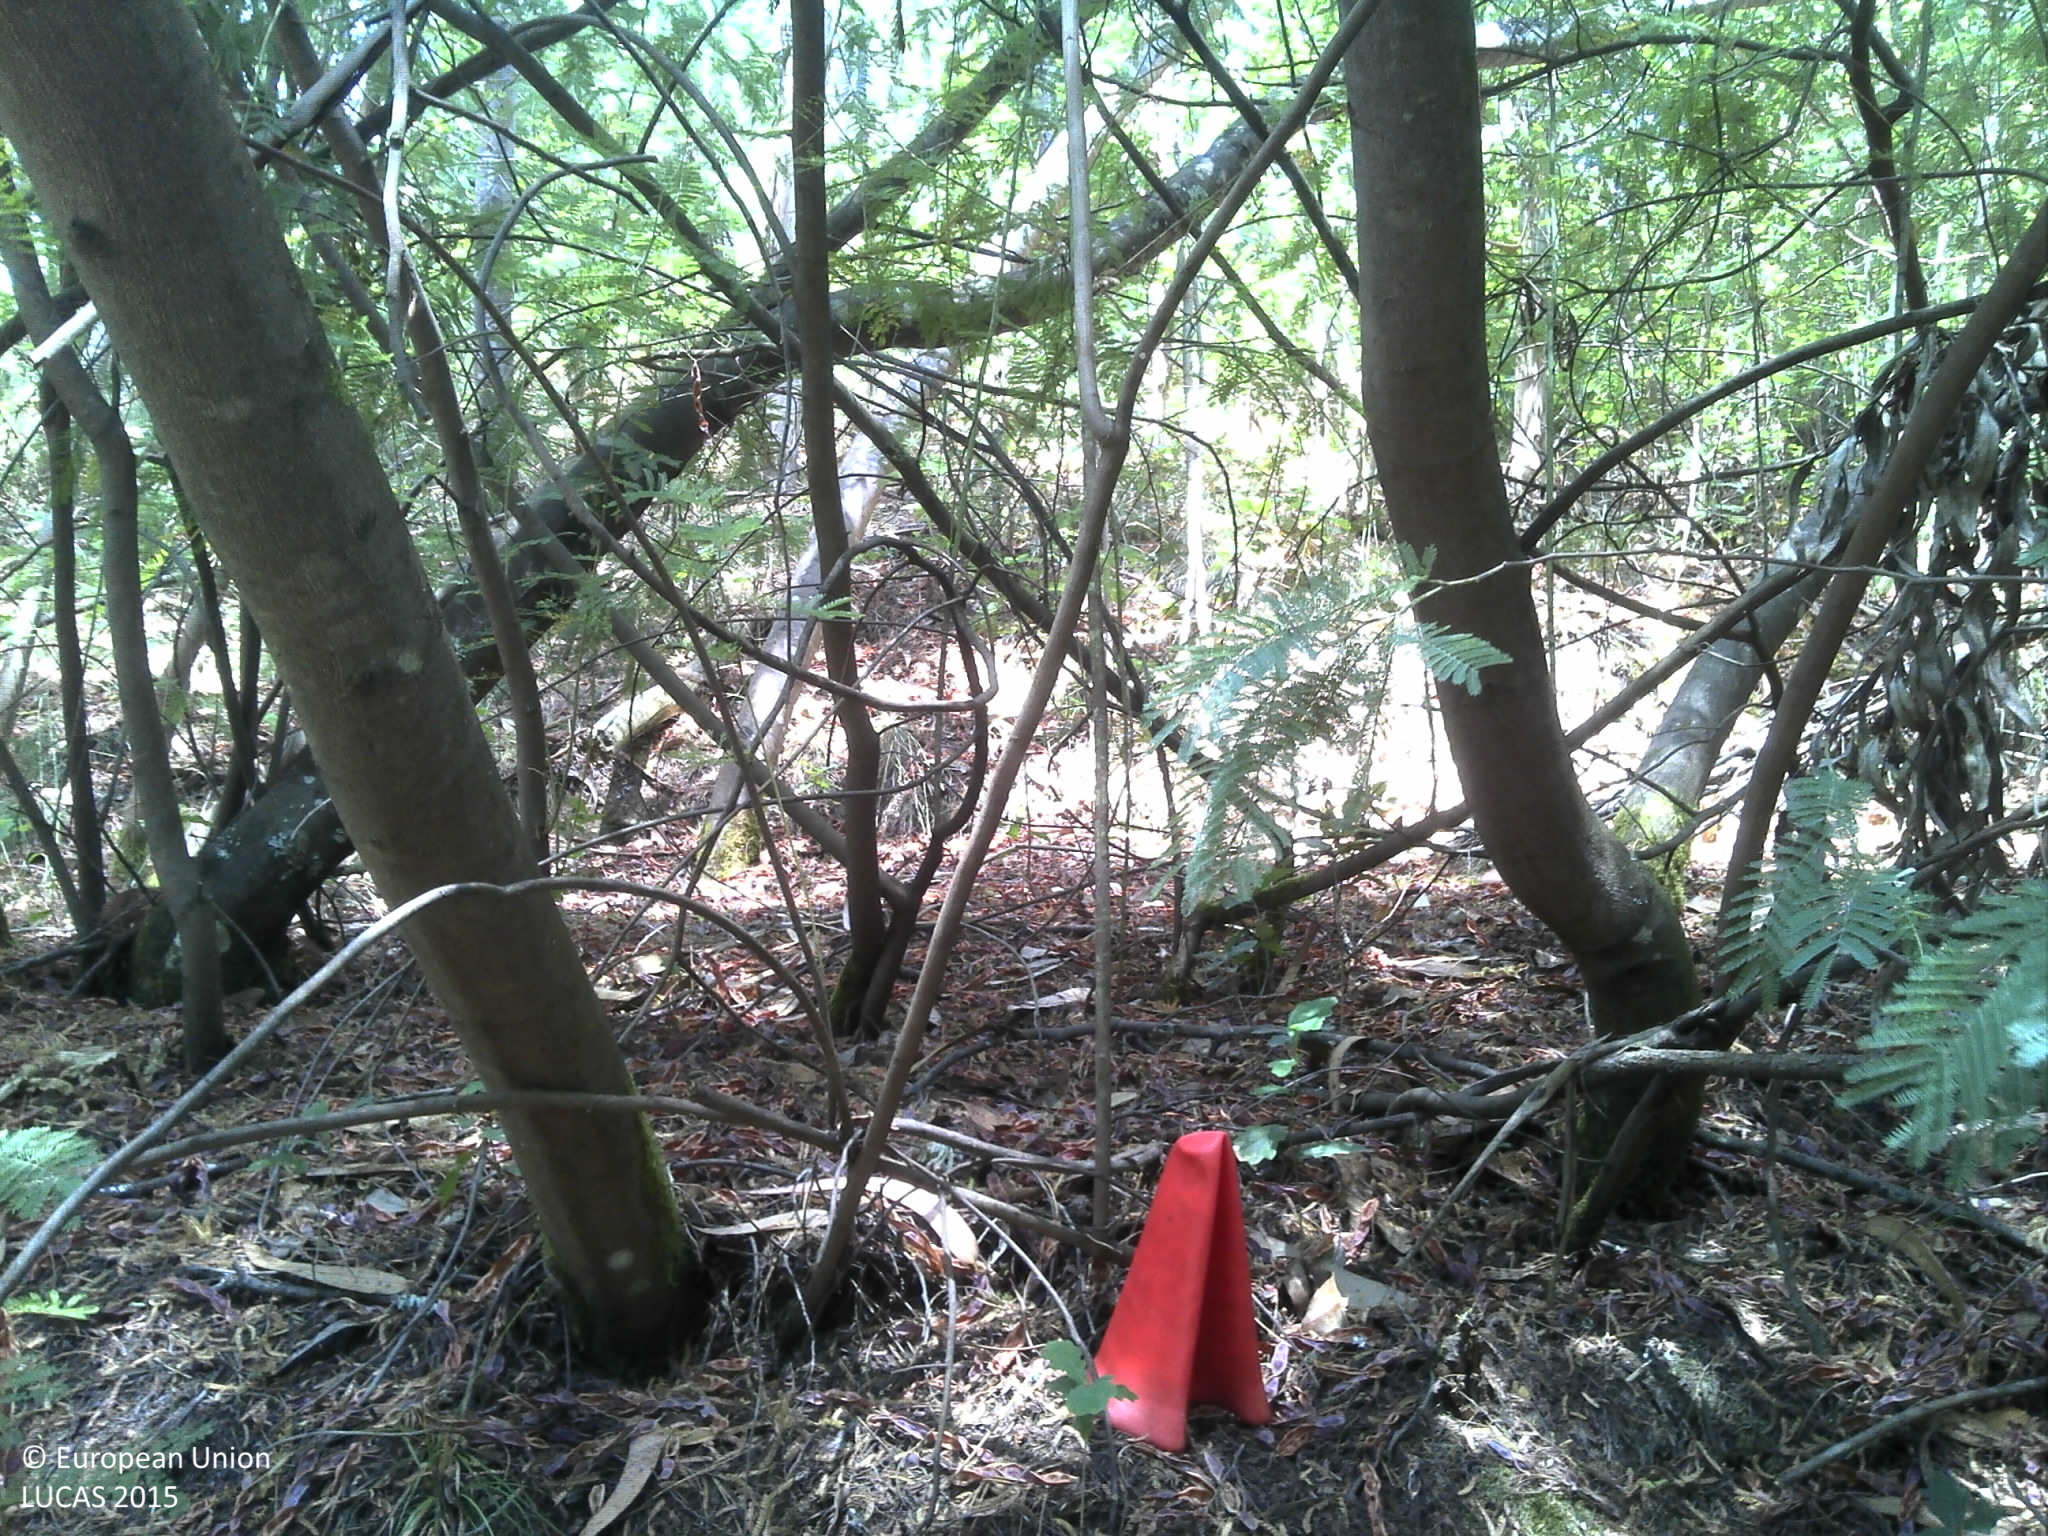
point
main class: Woodland
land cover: Broadleaved woodland
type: exotic forest
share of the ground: > 75 %
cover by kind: broadleaved forest trees 80 %, unconsolidated bare surface 15 %, shrubs 5 %
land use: Semi-natural and natural areas not in use
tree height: > 5 m
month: July
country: PT
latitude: 40.2376
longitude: -8.2631
